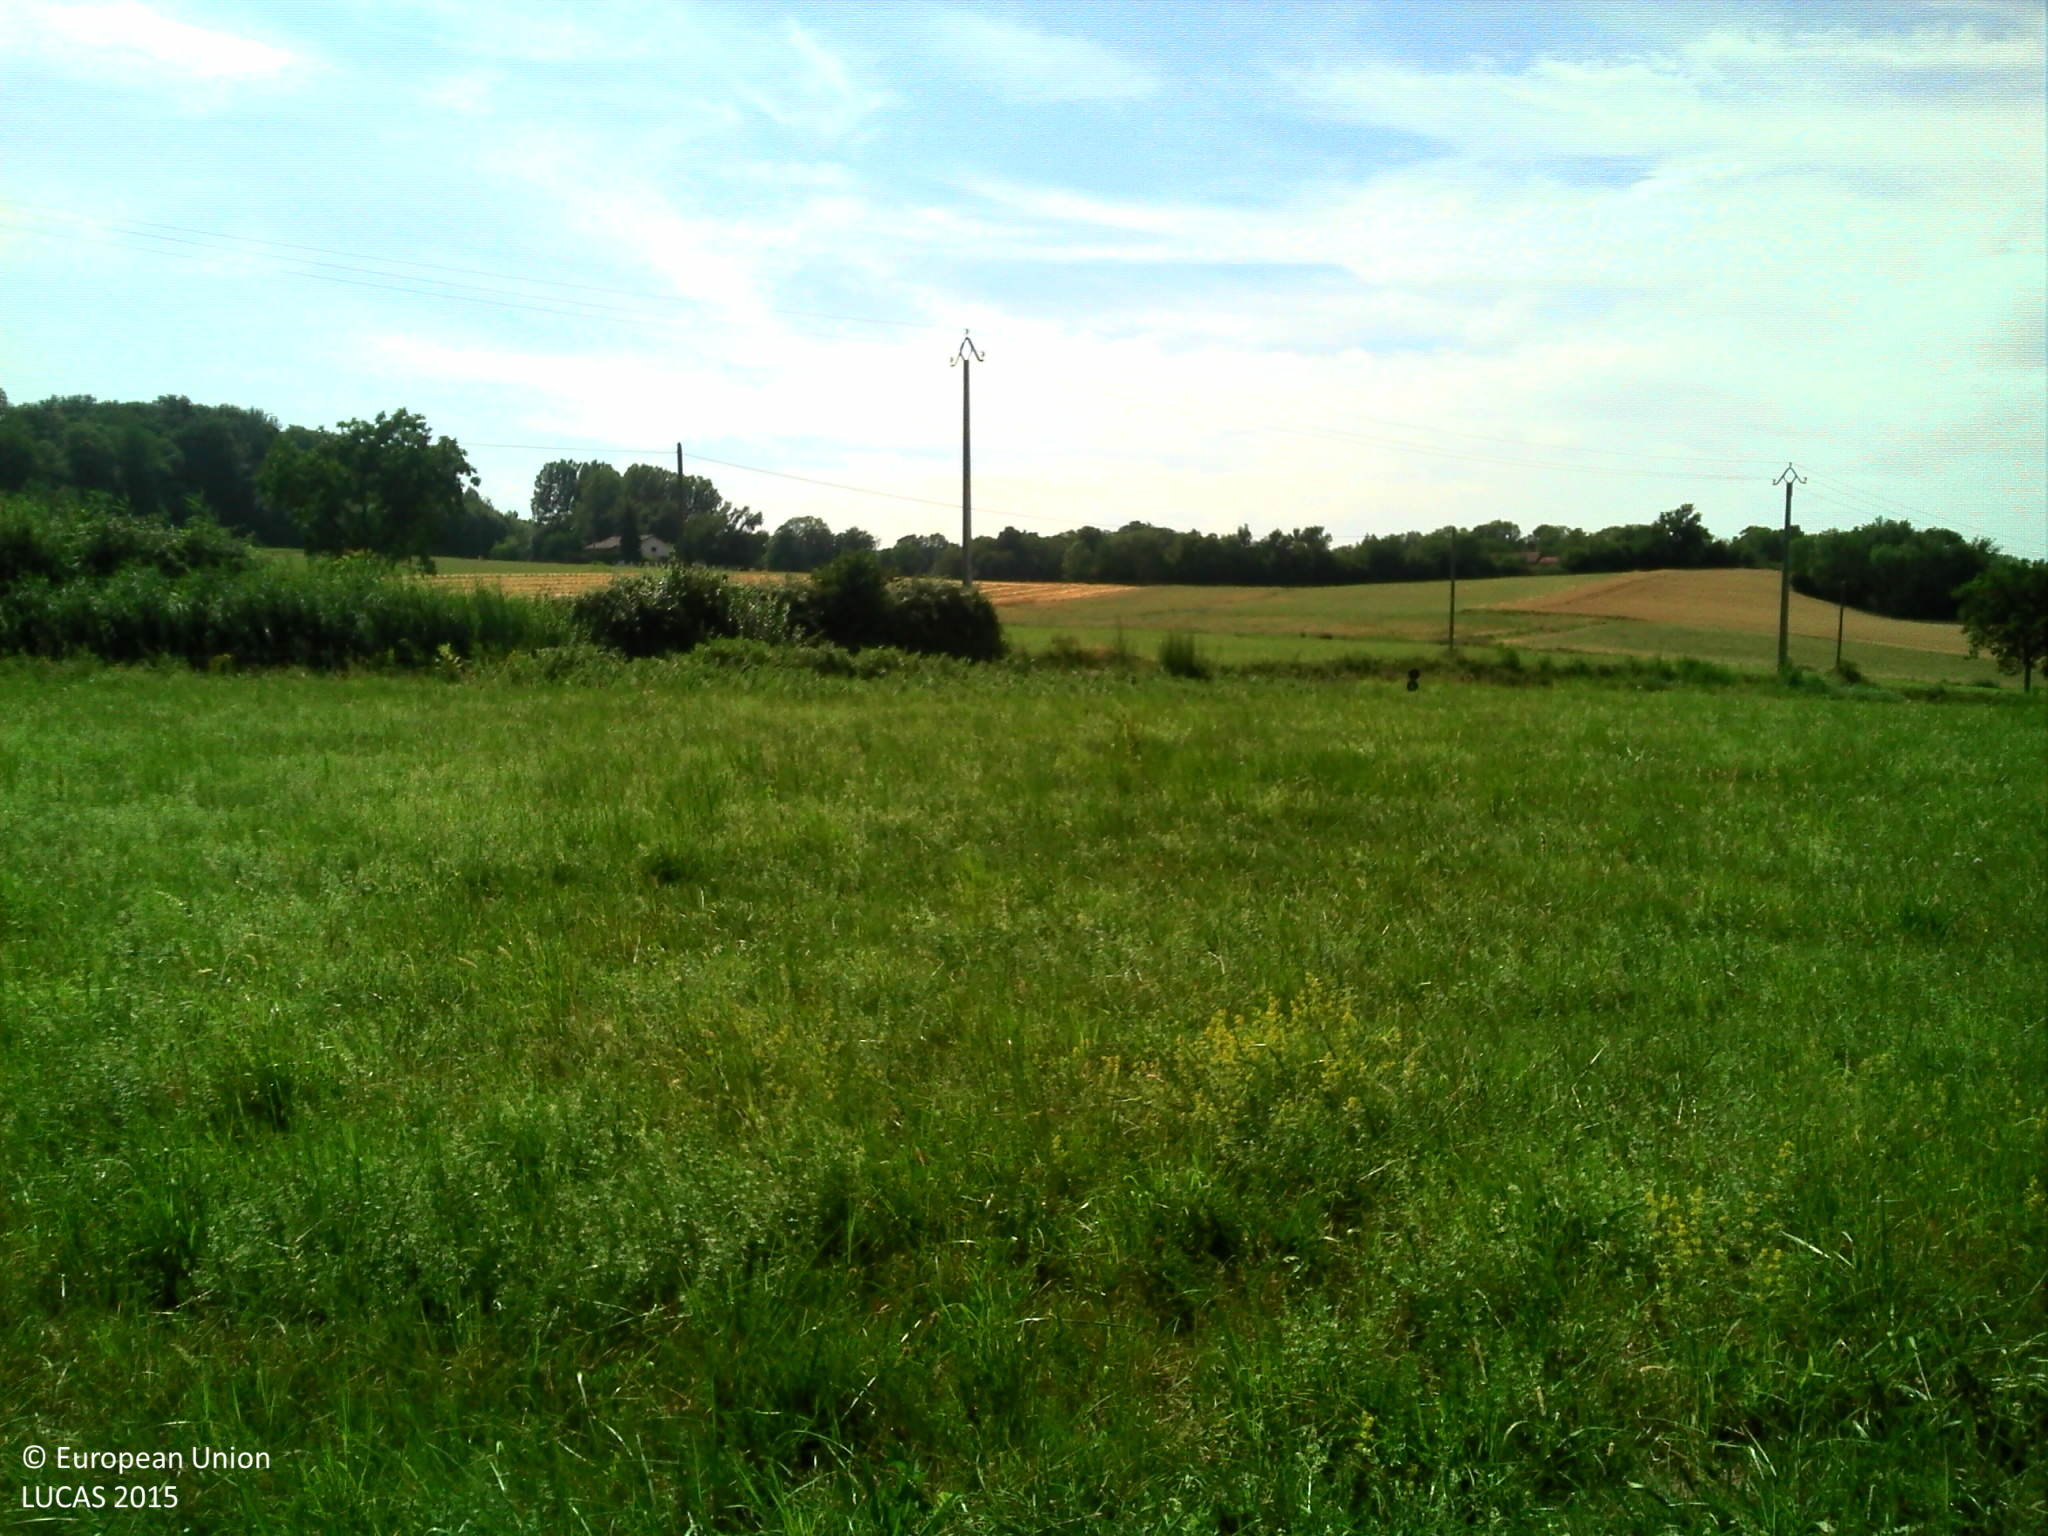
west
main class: Grassland
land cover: Grassland without tree/shrub cover
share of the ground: > 75 %
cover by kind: herbaceous plants 100 %
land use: Semi-natural and natural areas not in use
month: July
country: FR
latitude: 45.5309
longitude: 5.4077
